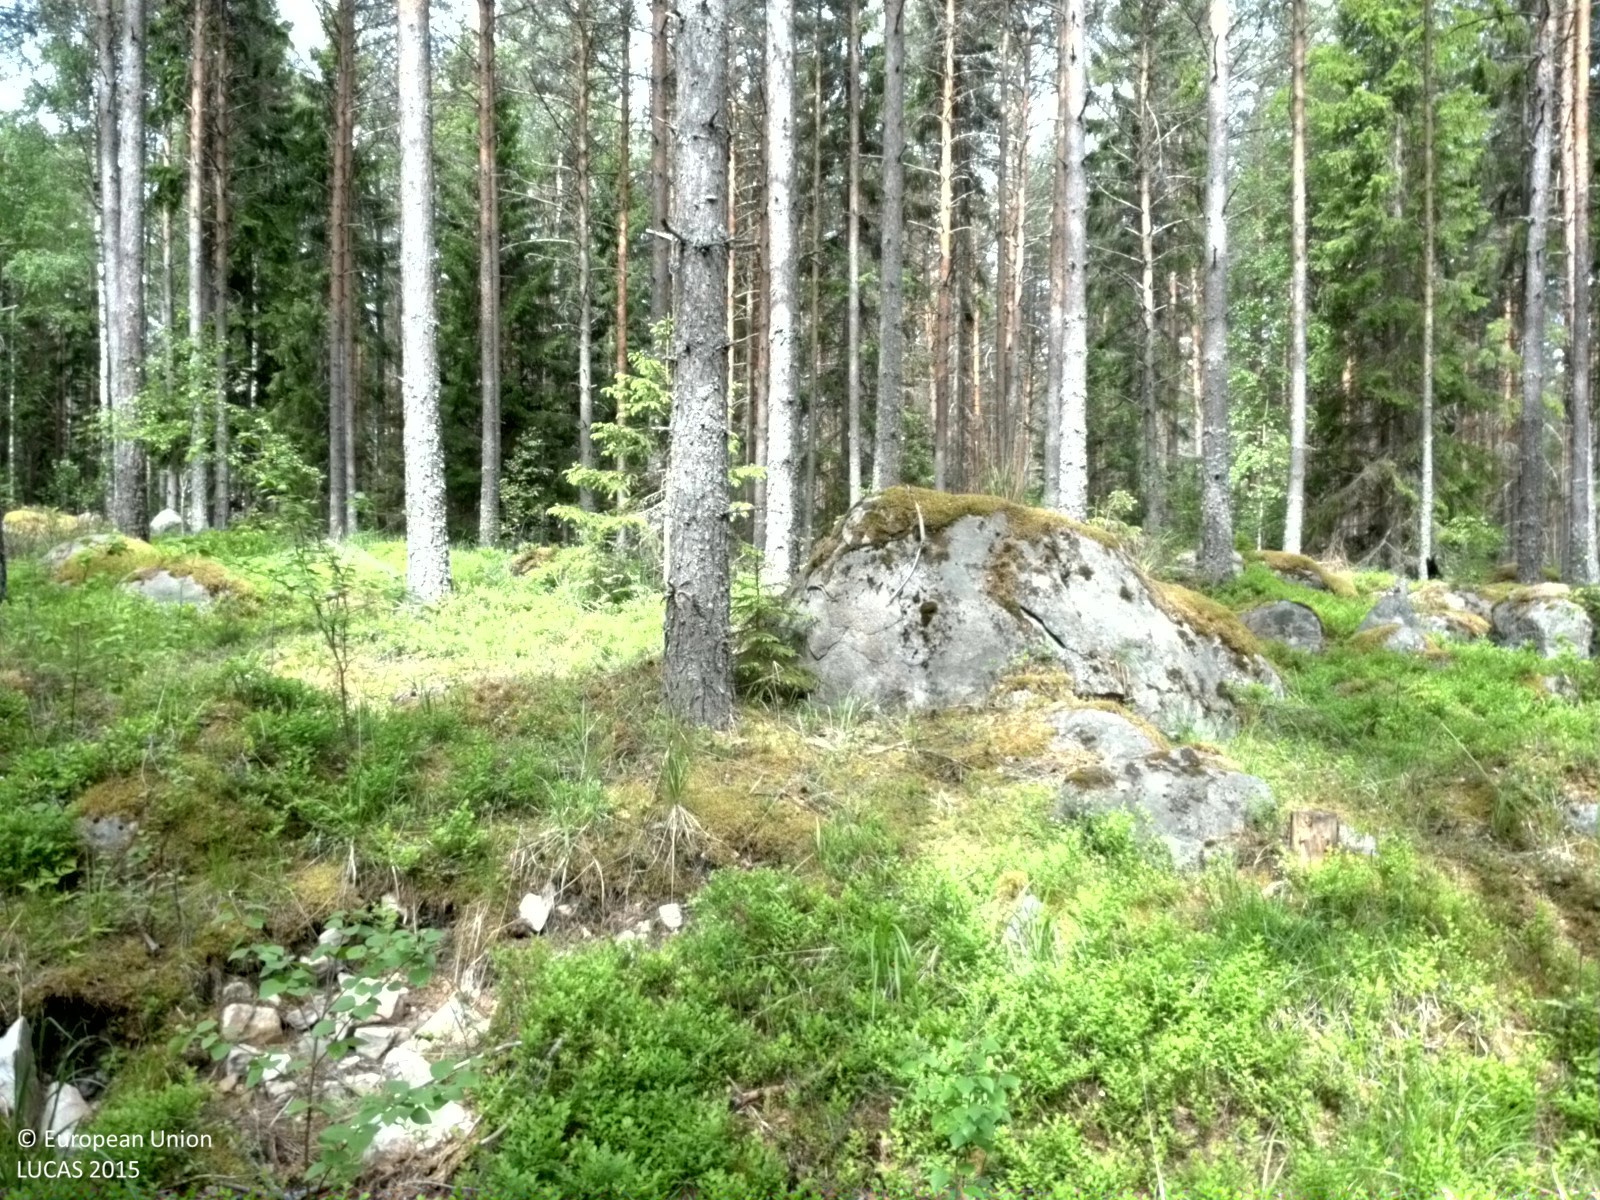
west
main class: Woodland
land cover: Pine dominated coniferous woodland
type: boreal forest
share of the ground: 50 - 75 %
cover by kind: coniferous forest trees 65 %, shrubs 15 %, herbaceous plants 10 %, broadleaved forest trees 5 %, lichens and mosses 5 %
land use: Forestry
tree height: > 5 m
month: June
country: SE
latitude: 60.2839
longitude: 17.2433
